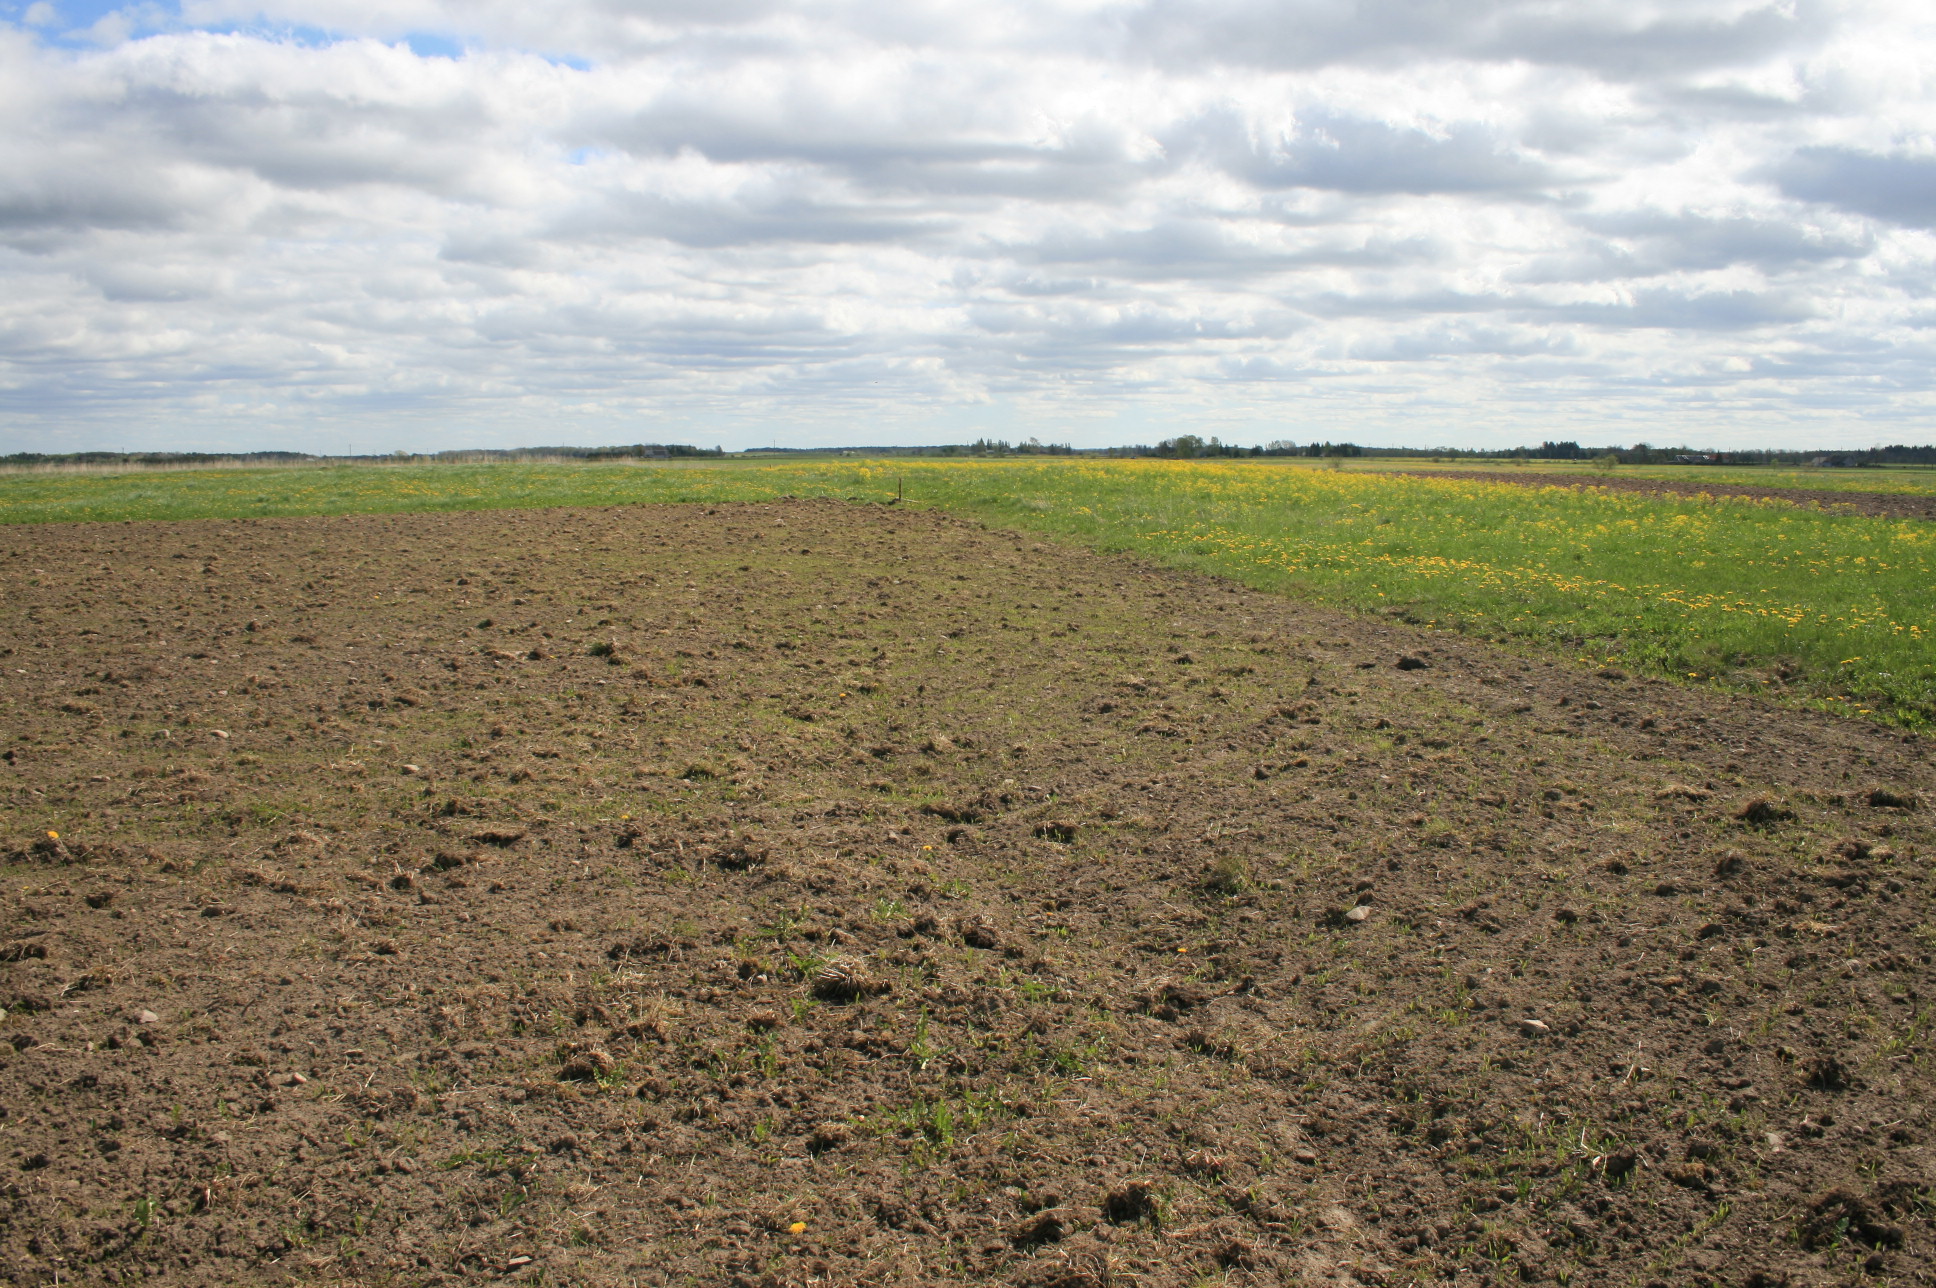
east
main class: Cropland
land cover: Oats
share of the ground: < 10 %
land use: Agriculture (excluding fallow land and kitchen gardens)
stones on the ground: < 10 %
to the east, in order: Oats; Grassland without tree/shrub cover; Barley
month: May
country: LT
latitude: 56.1695
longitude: 21.5923
